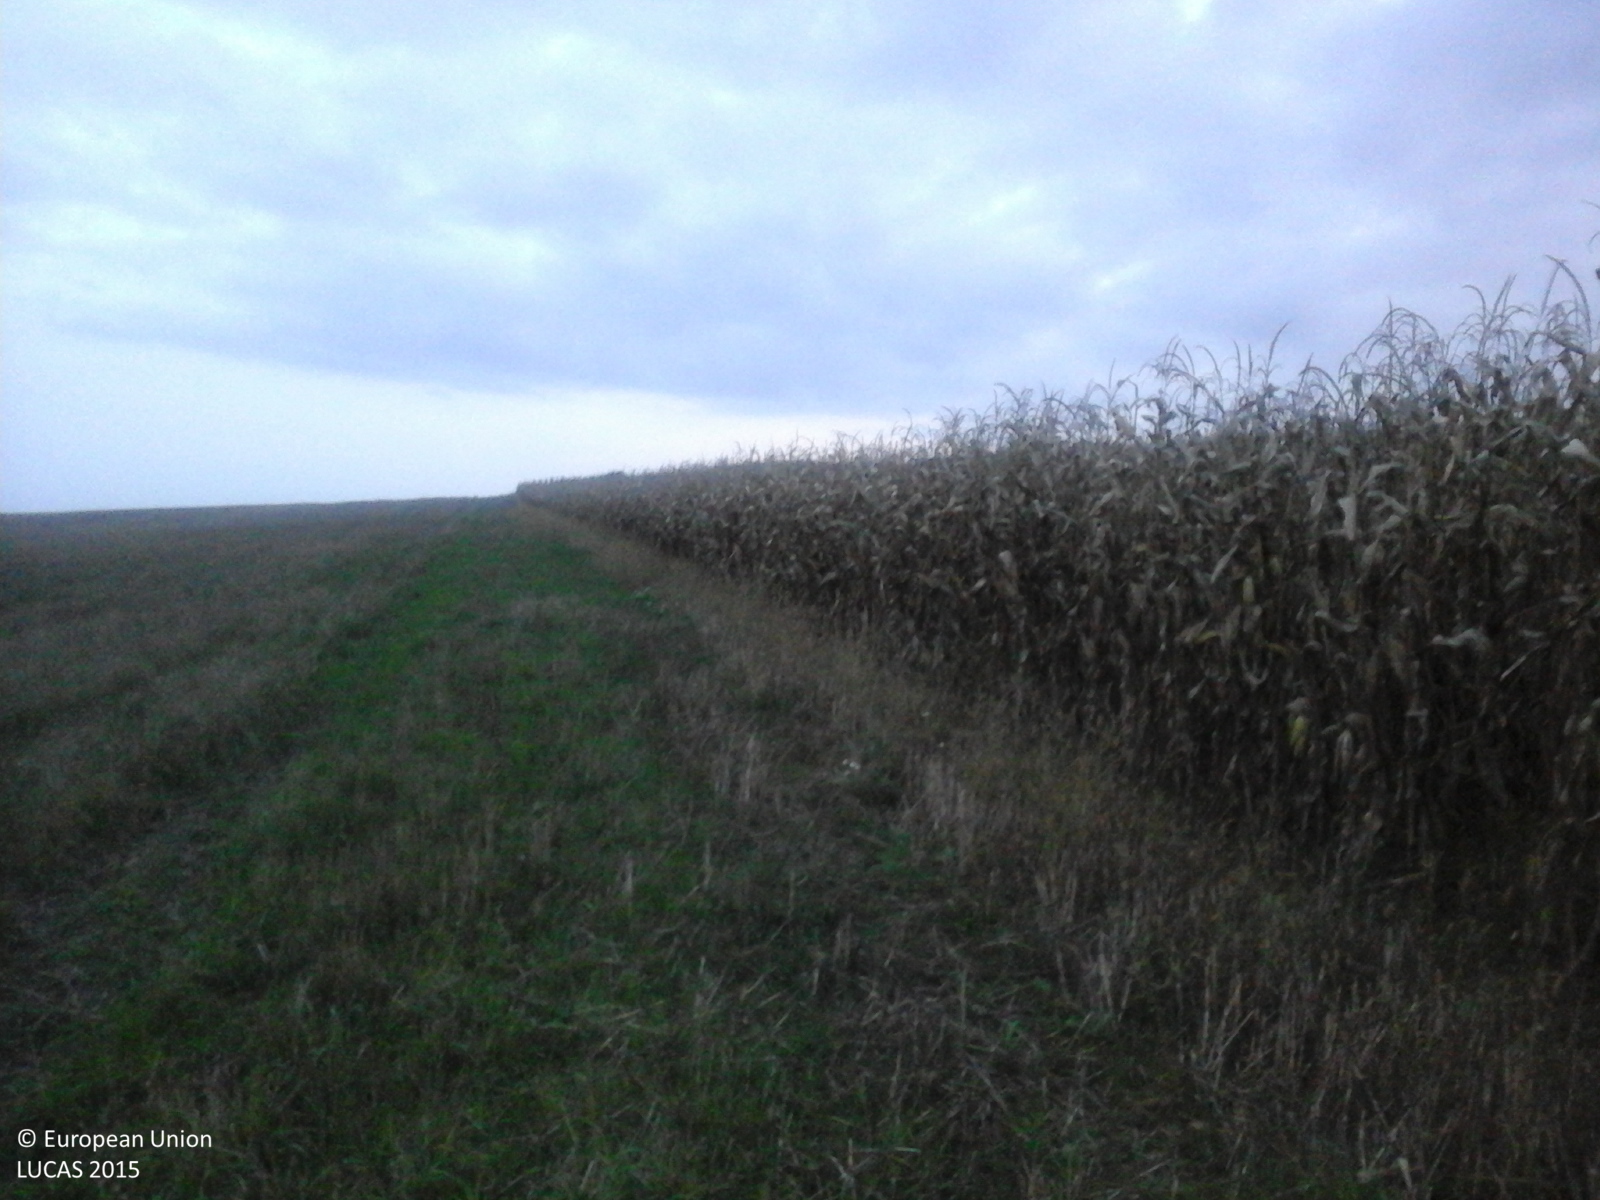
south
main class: Grassland
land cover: Grassland without tree/shrub cover
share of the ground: > 75 %
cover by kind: herbaceous plants 100 %
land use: Agriculture (excluding fallow land and kitchen gardens)
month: October
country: RO
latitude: 46.3212
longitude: 23.8529
